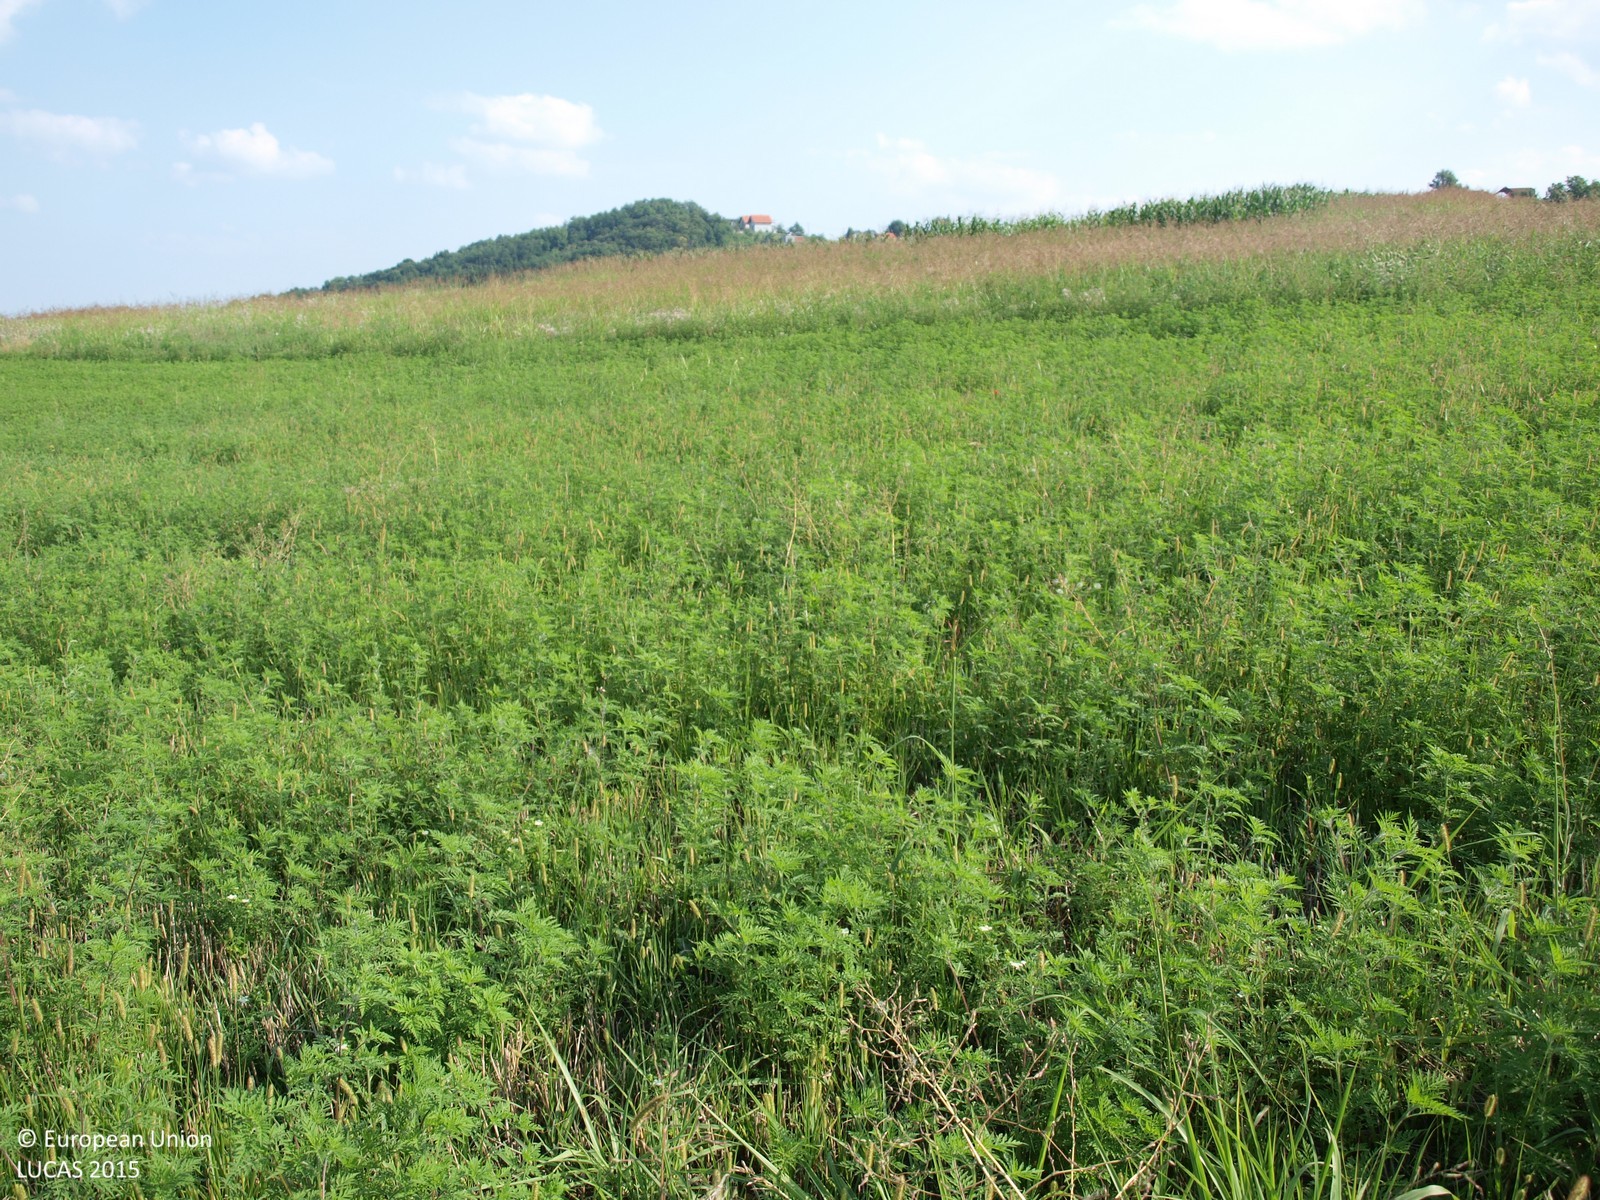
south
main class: Cropland
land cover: Barley
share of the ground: > 75 %
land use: Agriculture (excluding fallow land and kitchen gardens)
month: August
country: HR
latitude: 45.9543
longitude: 16.2046
